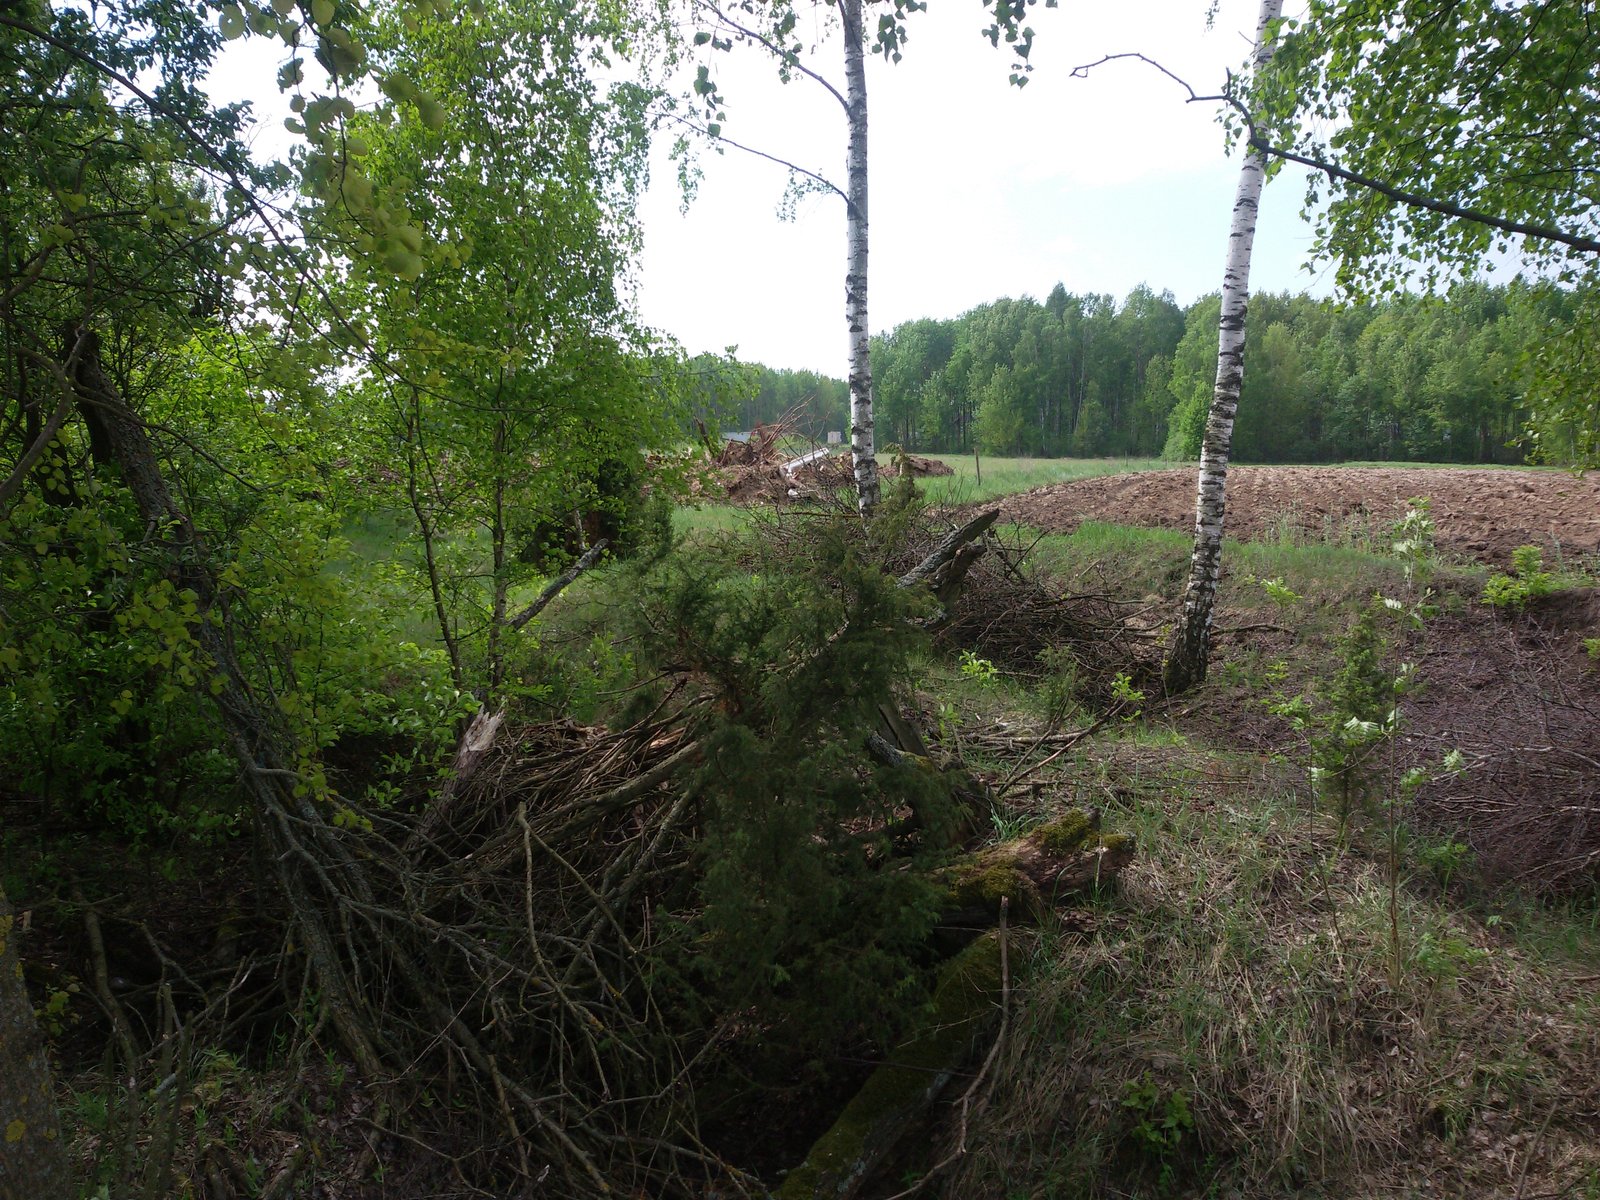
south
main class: Woodland
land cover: Broadleaved woodland
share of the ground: 25 - 50 %
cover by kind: unconsolidated bare surface 50 %, broadleaved forest trees 40 %, herbaceous plants 10 %
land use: Semi-natural and natural areas not in use
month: May
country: PL
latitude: 53.1672
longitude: 21.4329
